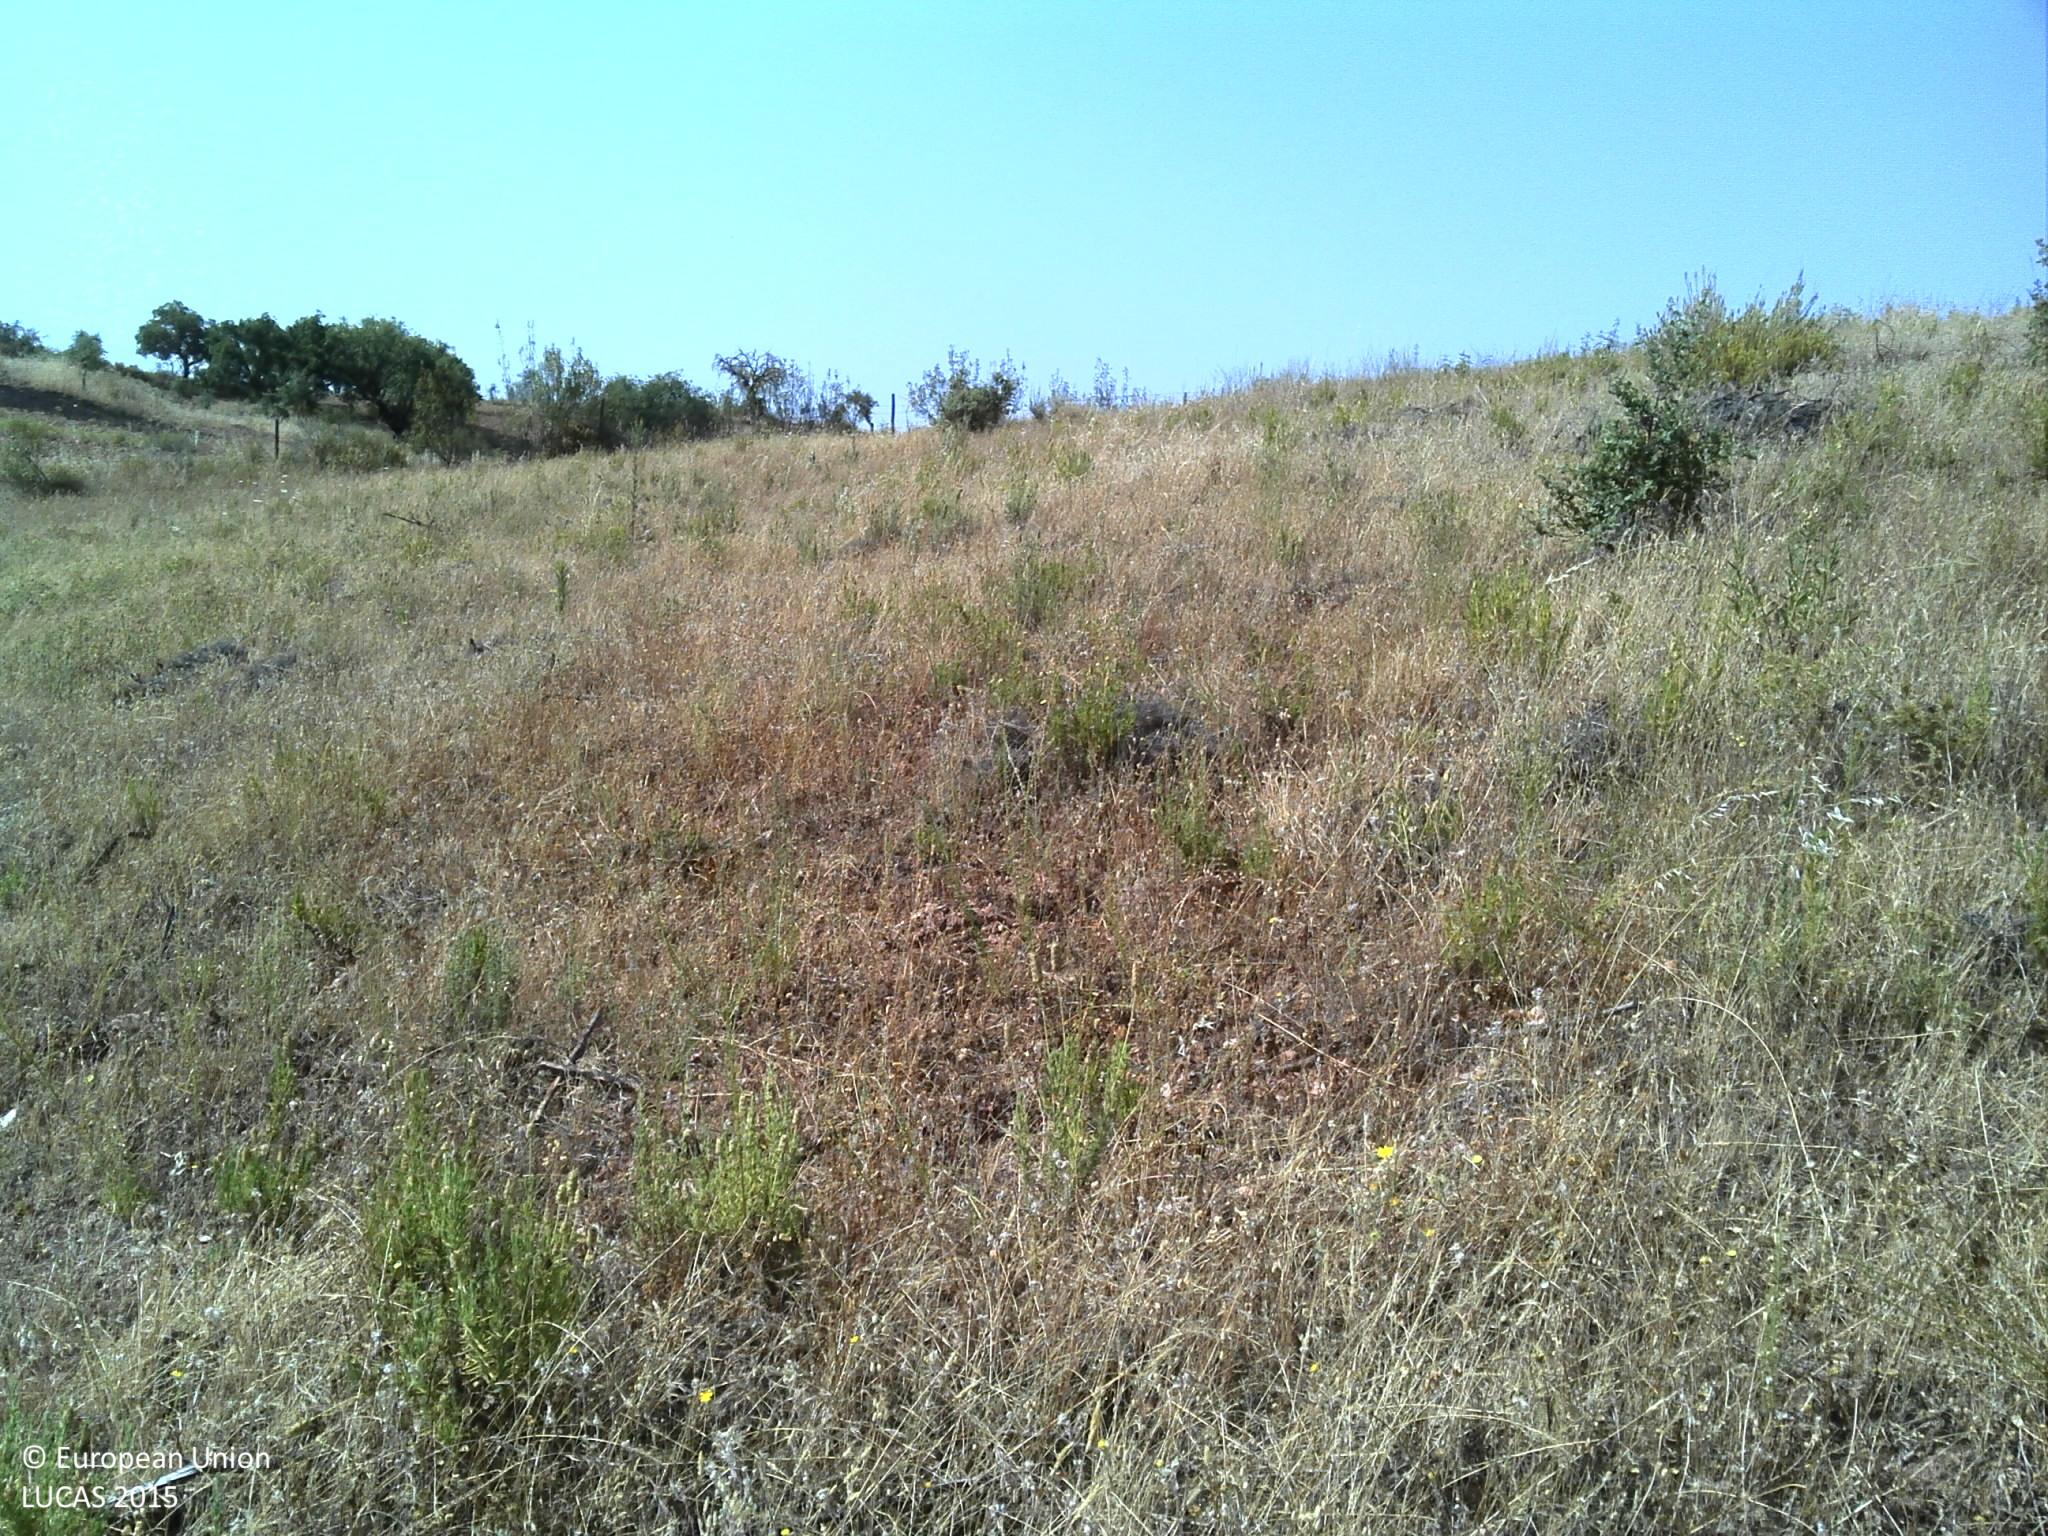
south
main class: Grassland
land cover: Grassland with sparse tree/shrub cover
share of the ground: 50 - 75 %
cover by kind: herbaceous plants 95 %, broadleaved forest trees 5 %
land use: Agriculture (excluding fallow land and kitchen gardens)
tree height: < 5 m
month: June
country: PT
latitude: 37.7776
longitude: -7.4879
